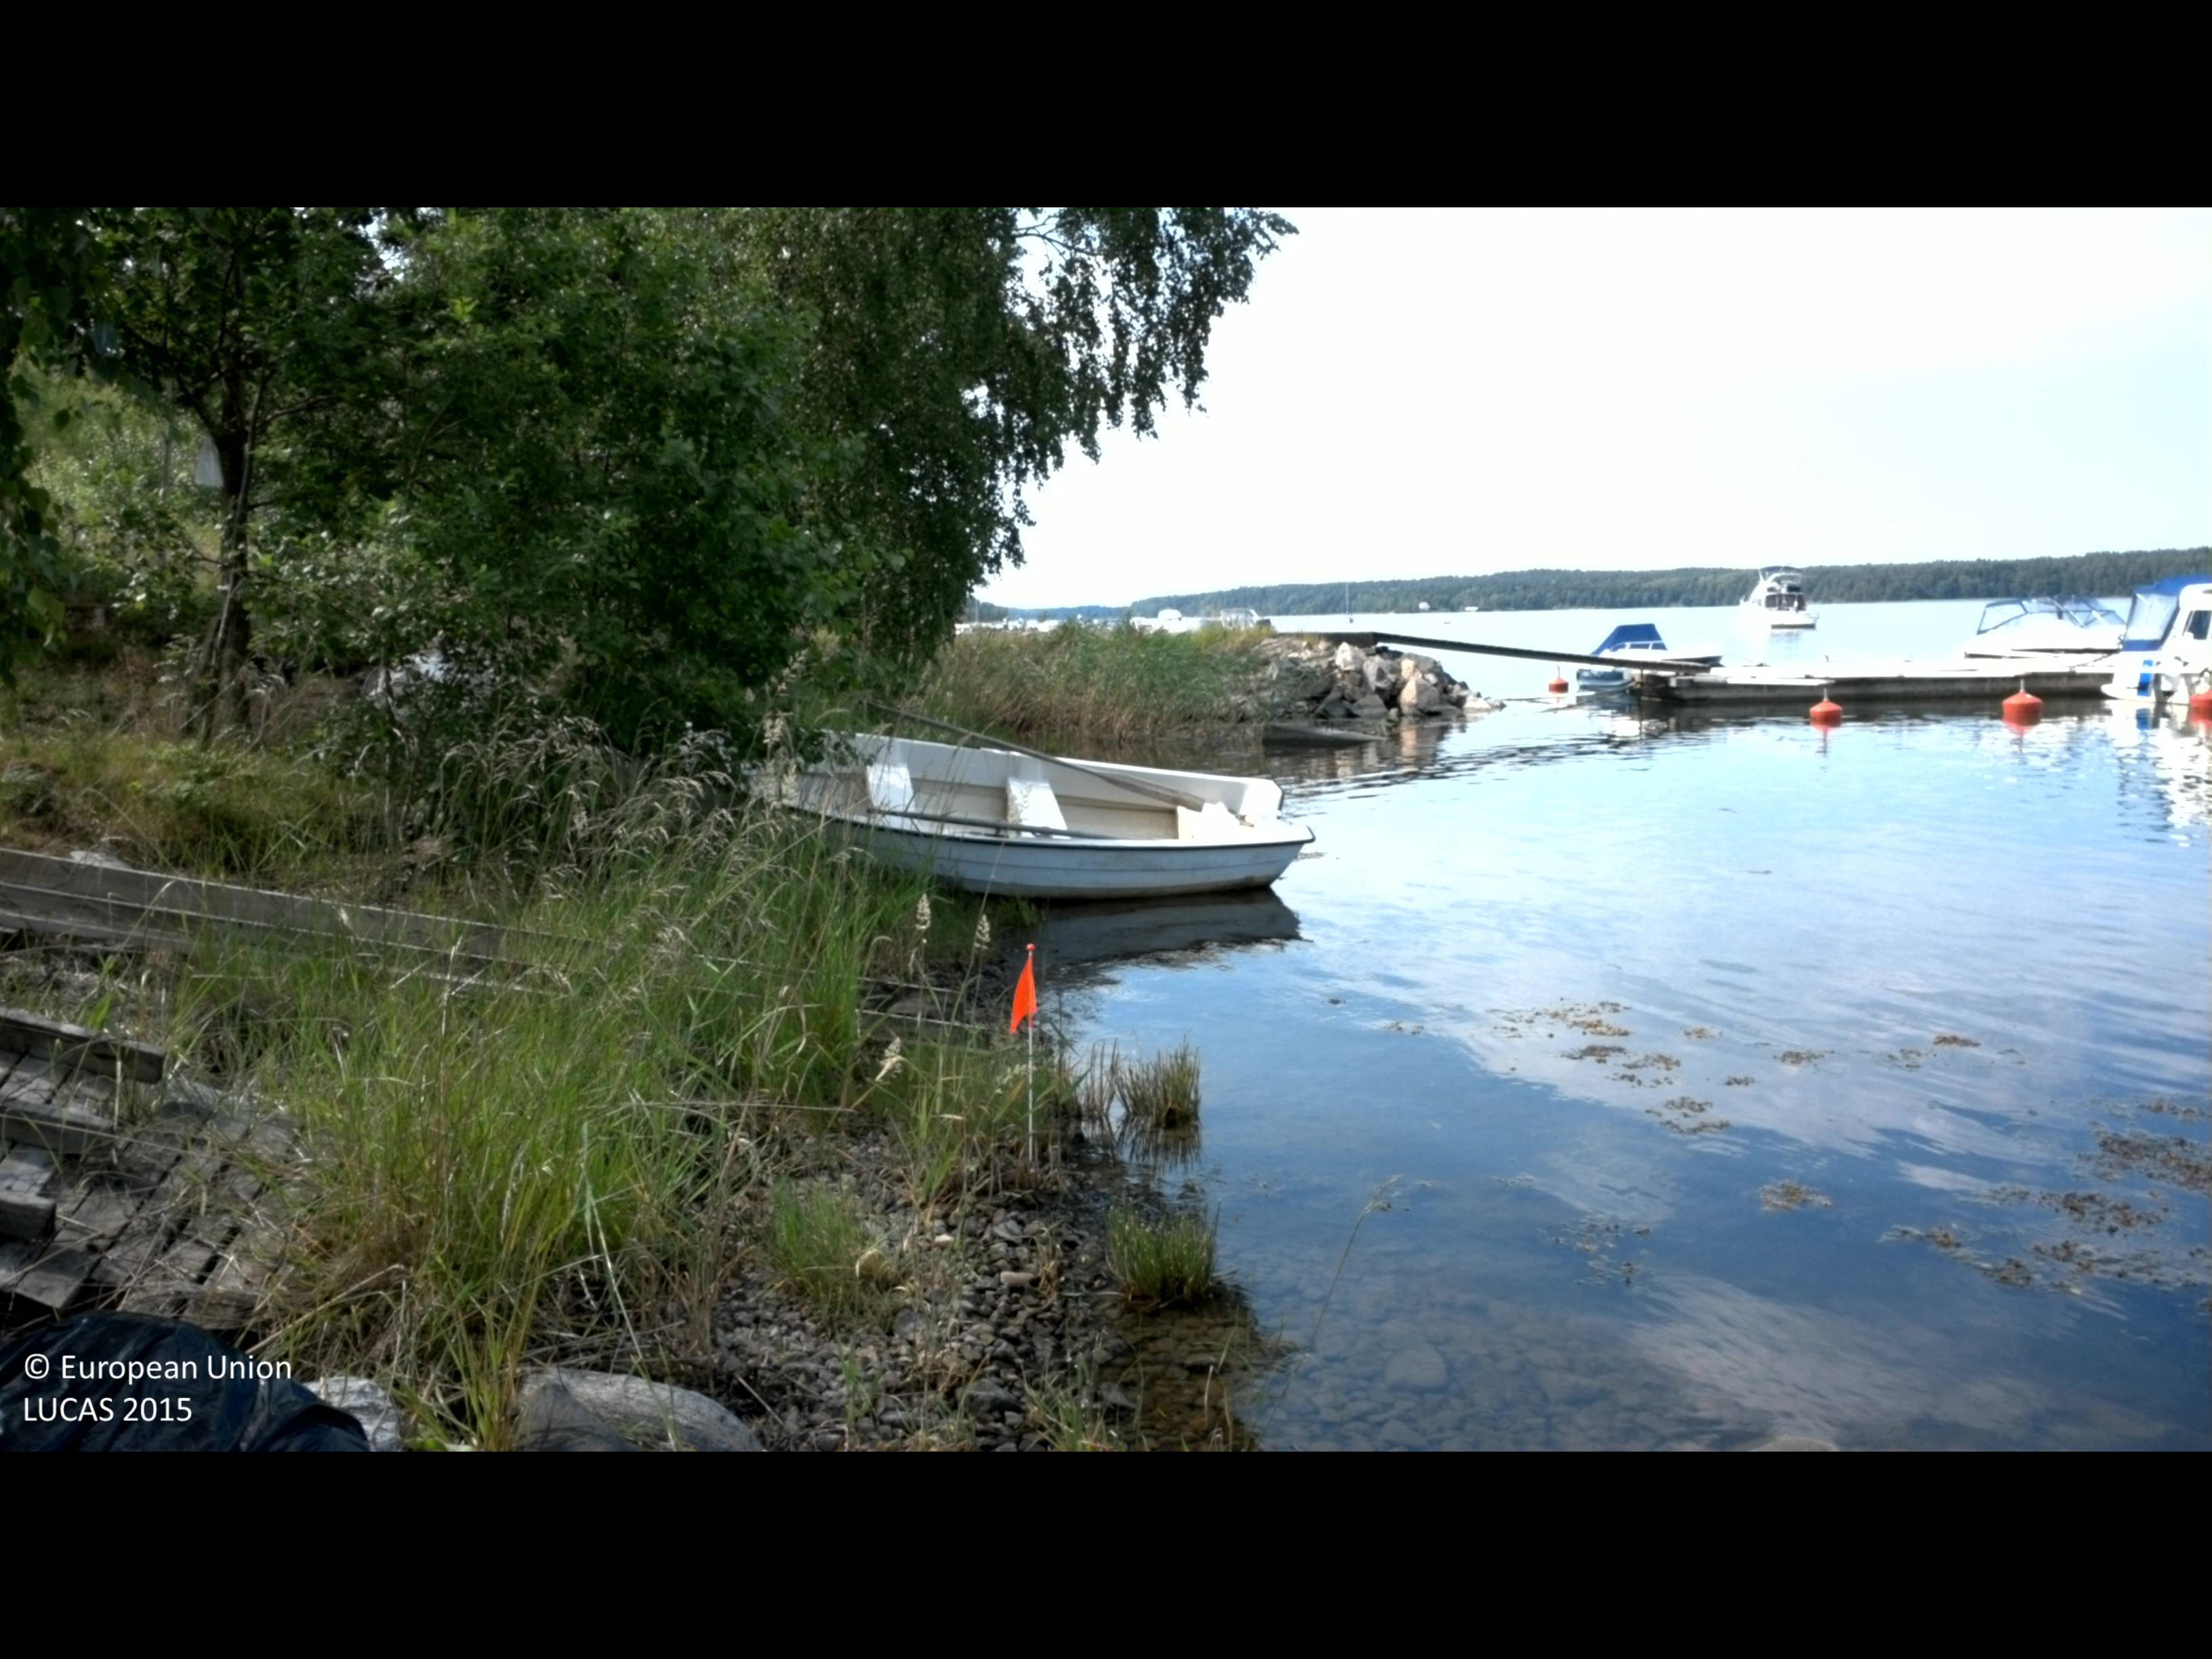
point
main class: Woodland
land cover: Broadleaved woodland
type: boreal forest
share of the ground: 50 - 75 %
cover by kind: broadleaved forest trees 65 %, shrubs 25 %, coniferous forest trees 5 %
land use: Amenities, museums, leisure
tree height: > 5 m
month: July
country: SE
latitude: 58.3229
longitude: 16.7071
